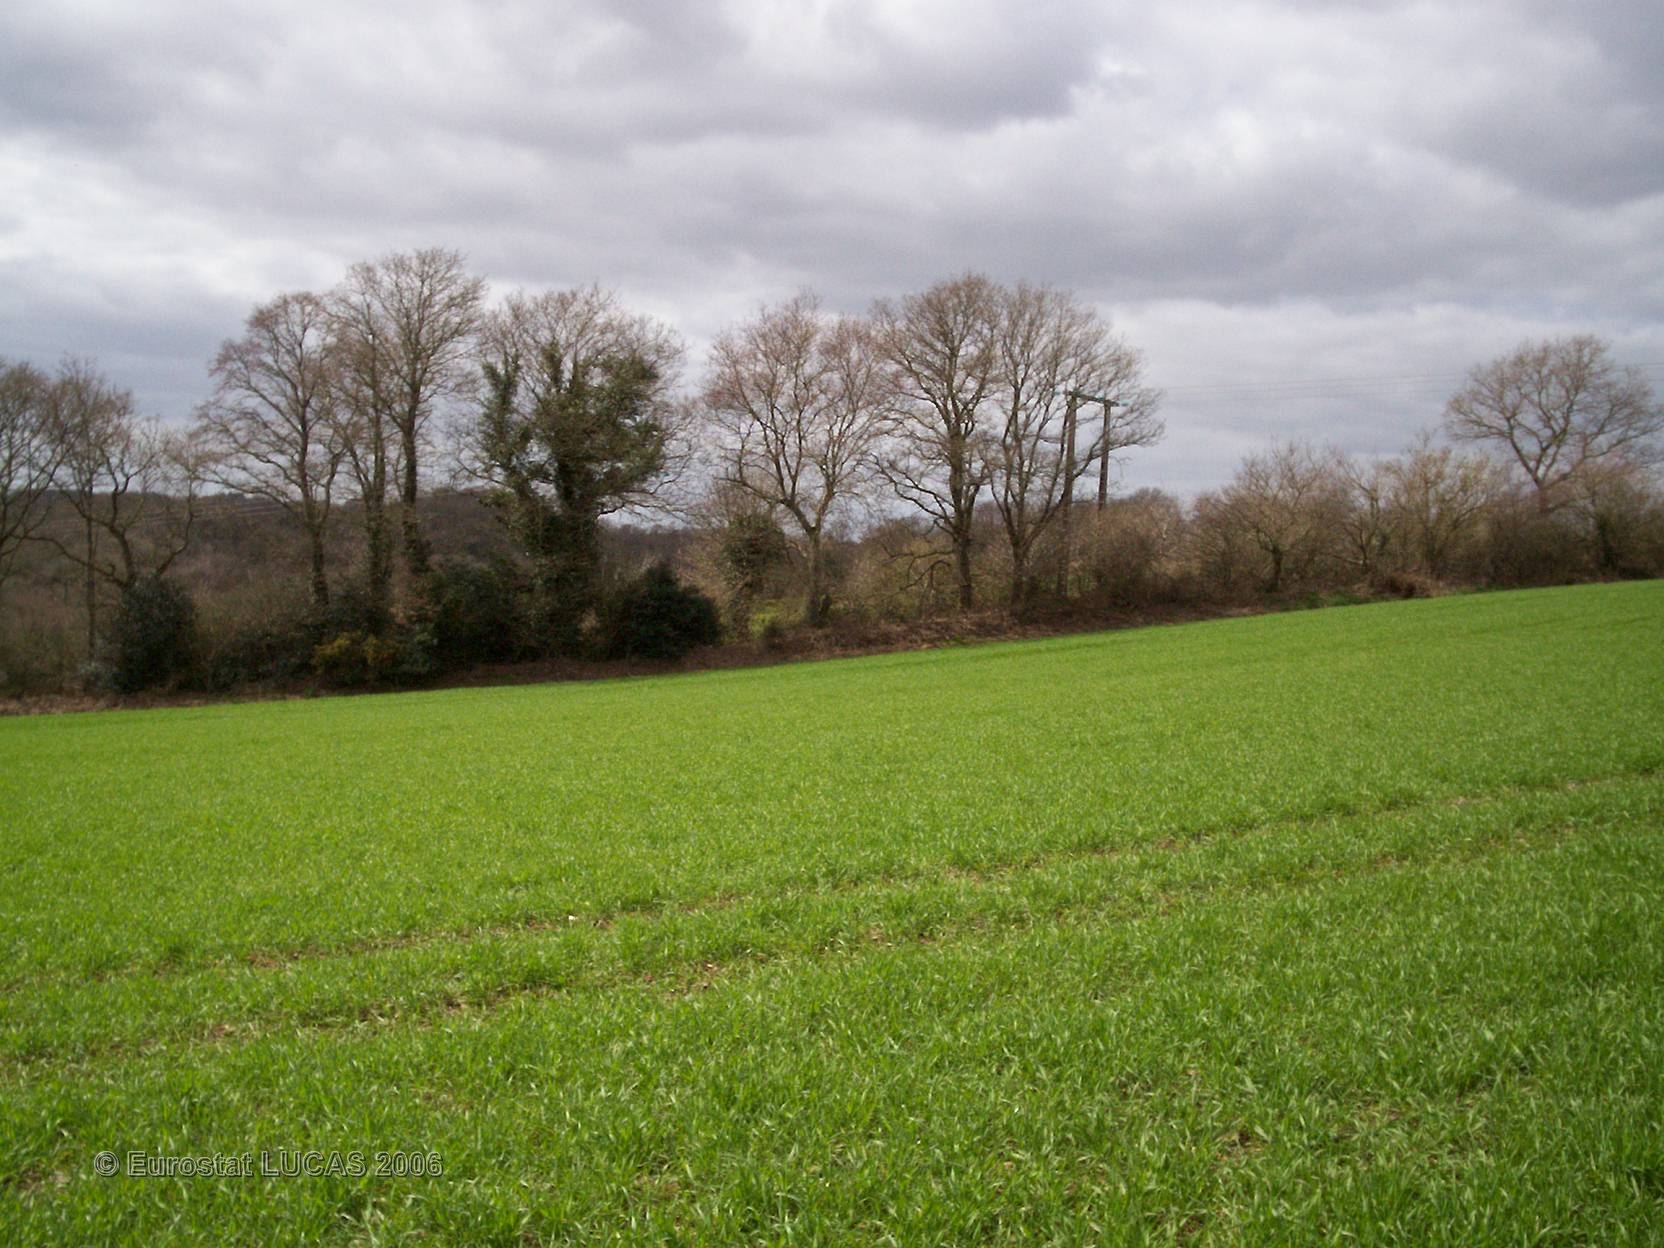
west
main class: Cropland
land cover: Common wheat
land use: Agriculture (excluding fallow land and kitchen gardens)
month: April
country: FR
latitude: 48.2178
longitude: -3.5788
